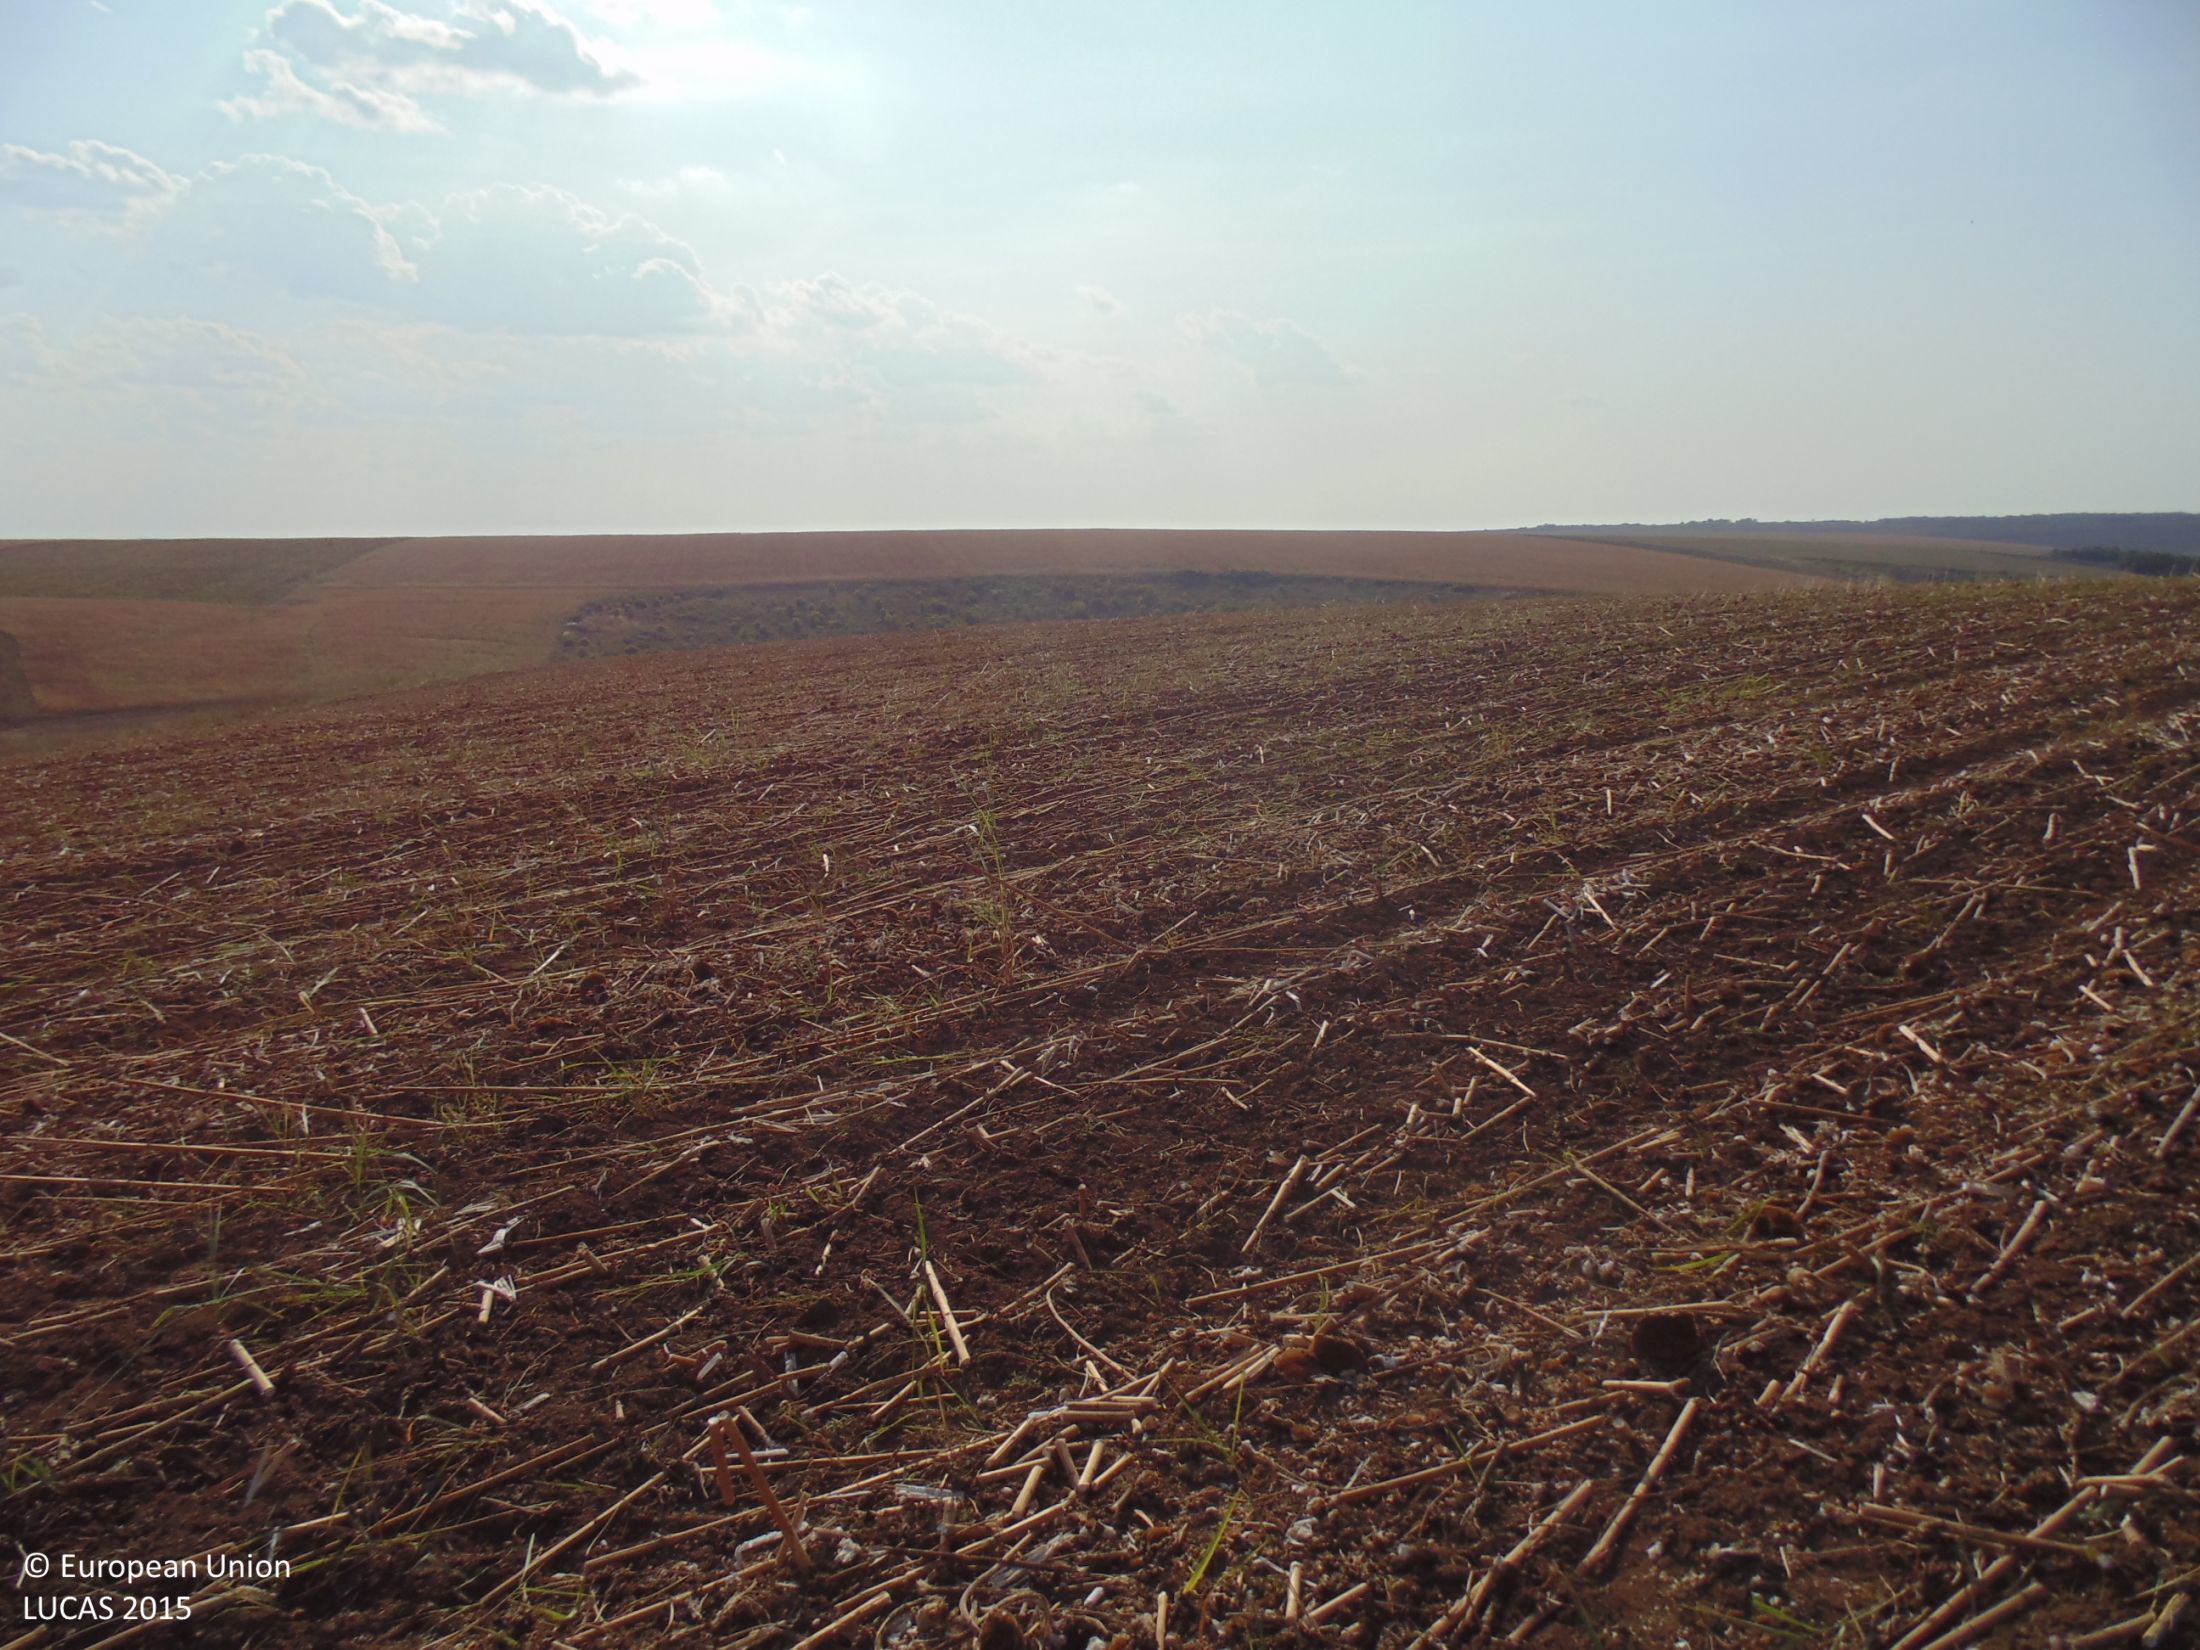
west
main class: Cropland
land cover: Sunflower
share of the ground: 10 - 25 %
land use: Agriculture (excluding fallow land and kitchen gardens)
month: August
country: BG
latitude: 43.9445
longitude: 27.2356
